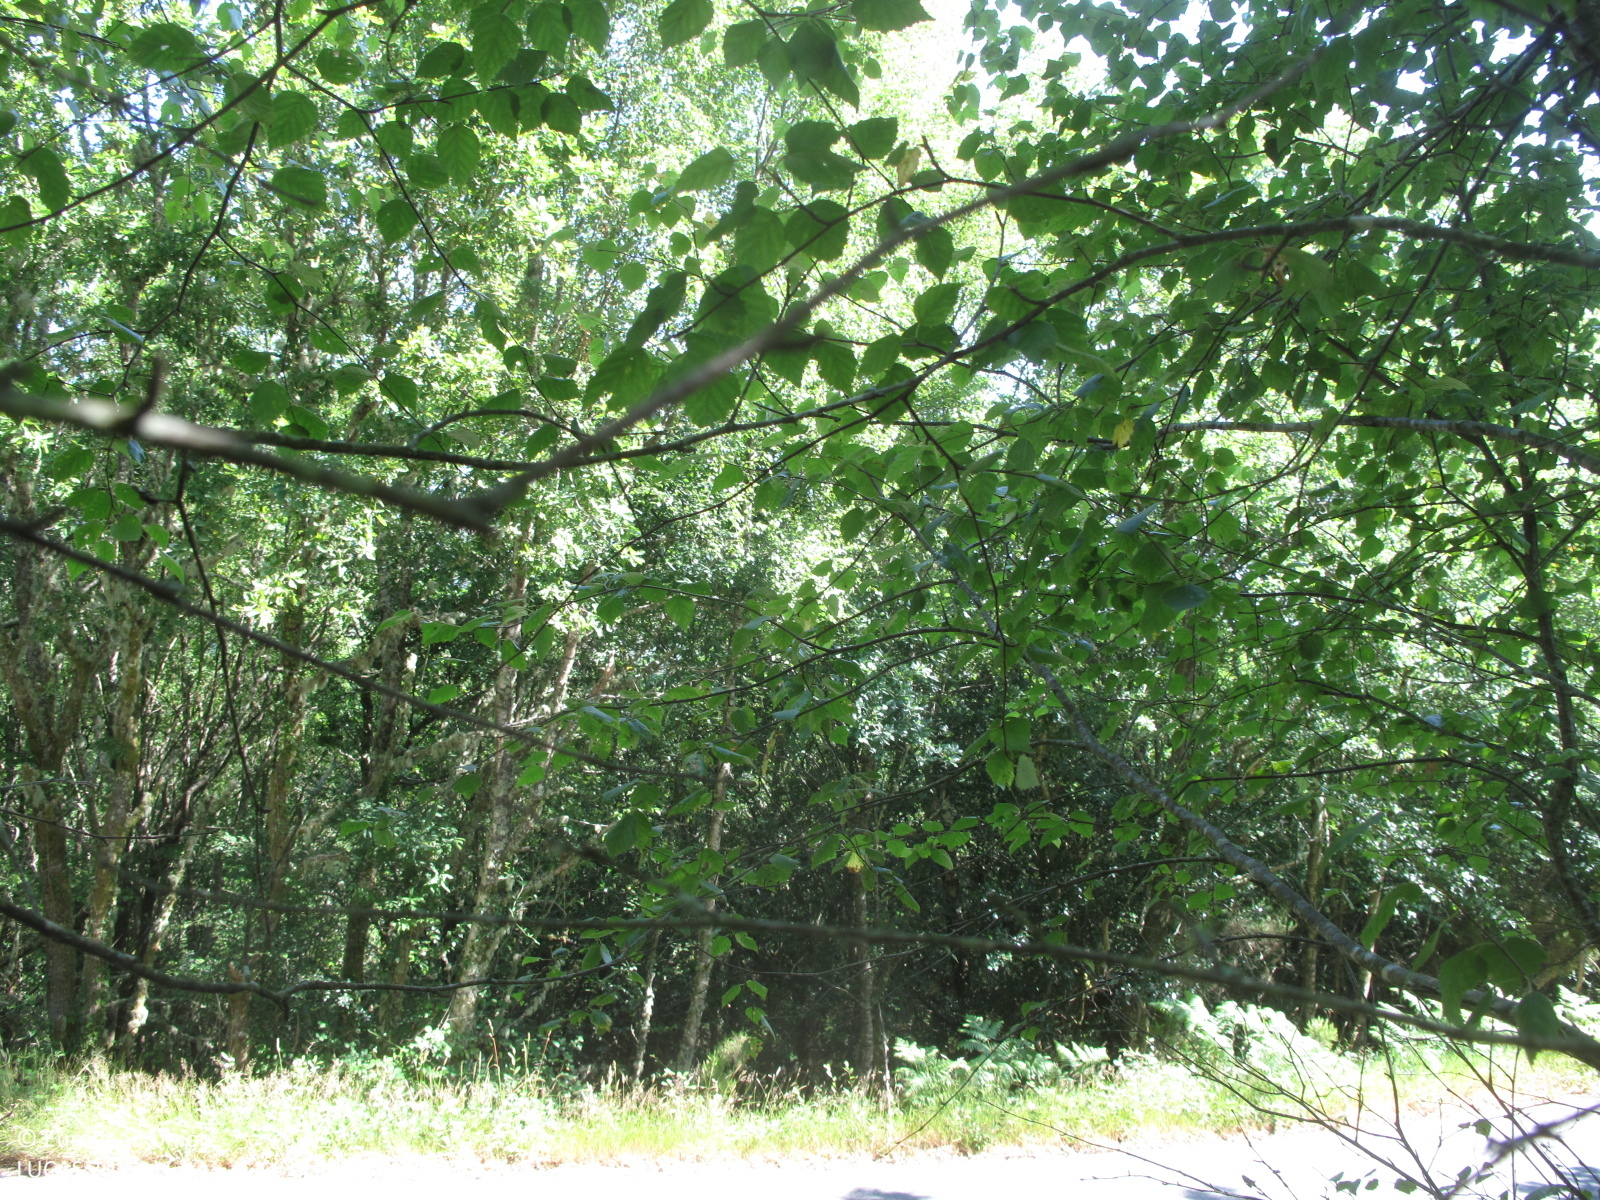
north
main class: Woodland
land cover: Broadleaved woodland
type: acidophilous oak and oak-birch forest
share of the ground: 50 - 75 %
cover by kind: broadleaved forest trees 60 %, shrubs 30 %, herbaceous plants 10 %
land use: Semi-natural and natural areas not in use
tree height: > 5 m
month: July
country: ES
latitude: 43.3341
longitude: -7.9900
